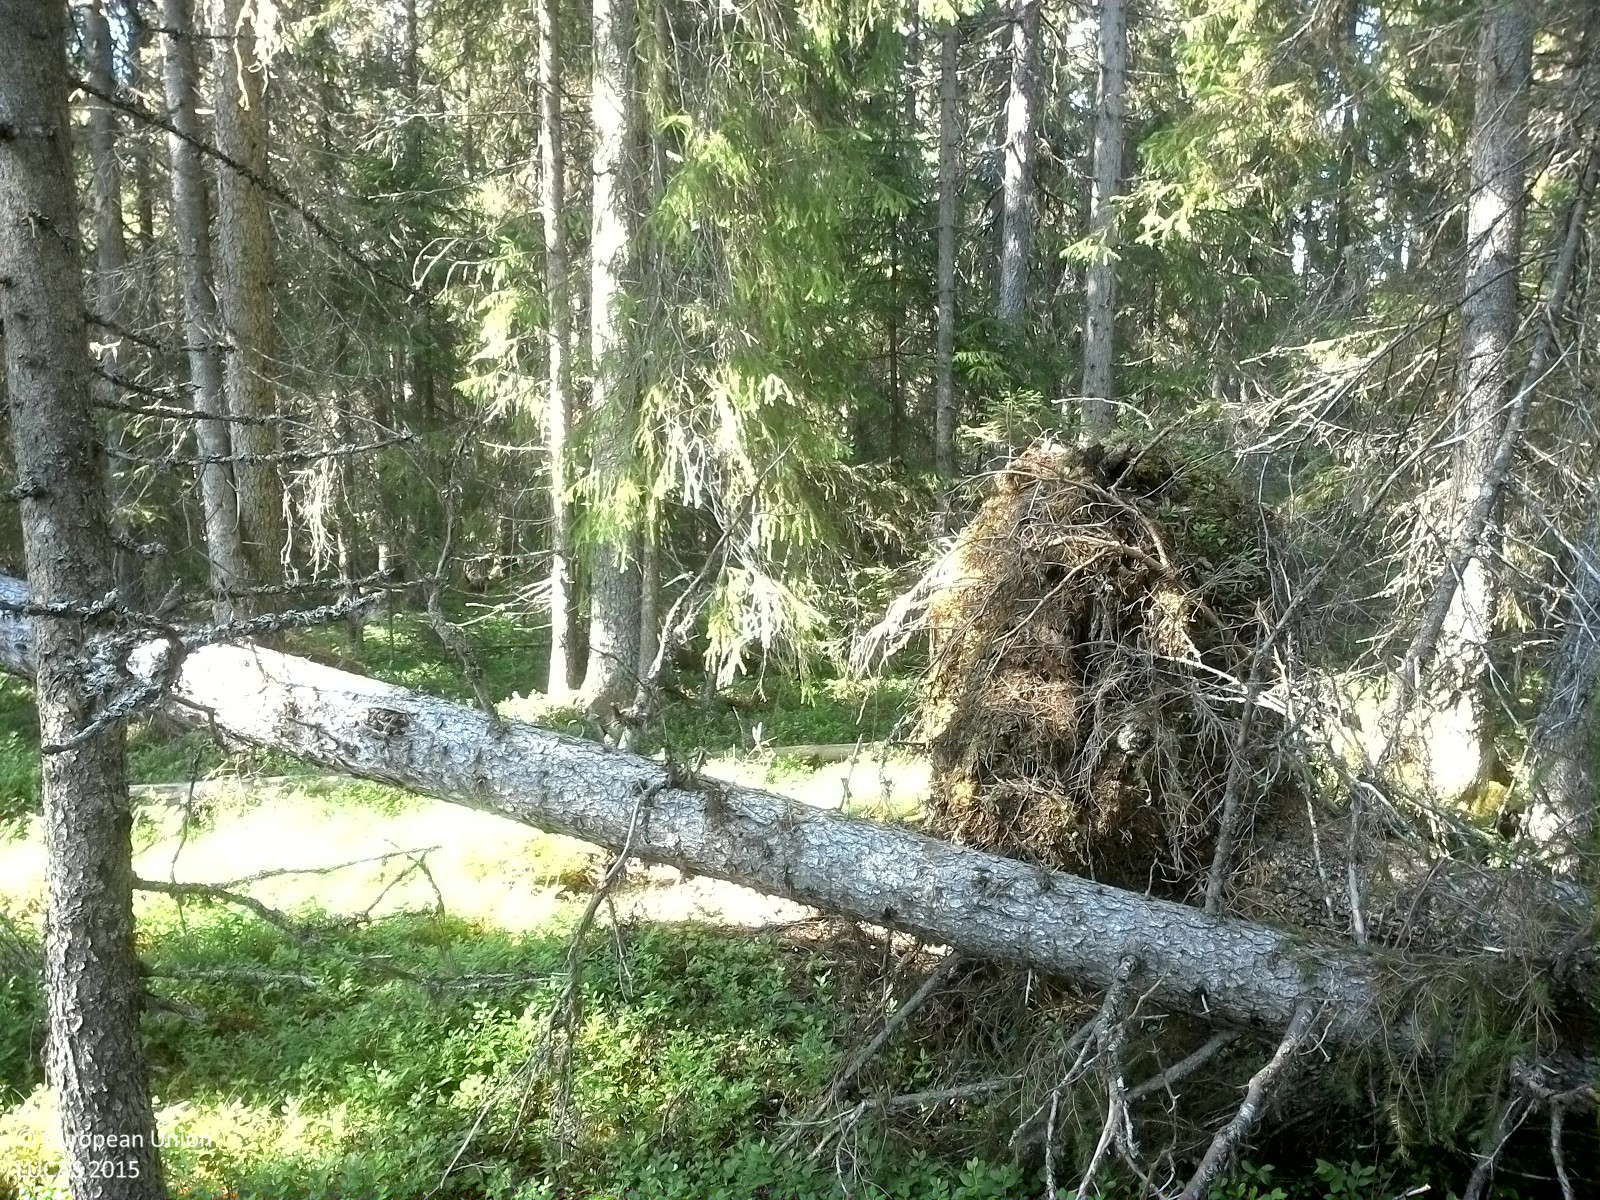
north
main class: Woodland
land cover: Spruce dominated coniferous woodland
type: boreal forest
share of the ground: > 75 %
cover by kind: coniferous forest trees 80 %, shrubs 20 %
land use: Forestry
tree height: > 5 m
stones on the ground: < 10 %
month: July
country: SE
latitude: 63.6267
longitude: 15.1609
